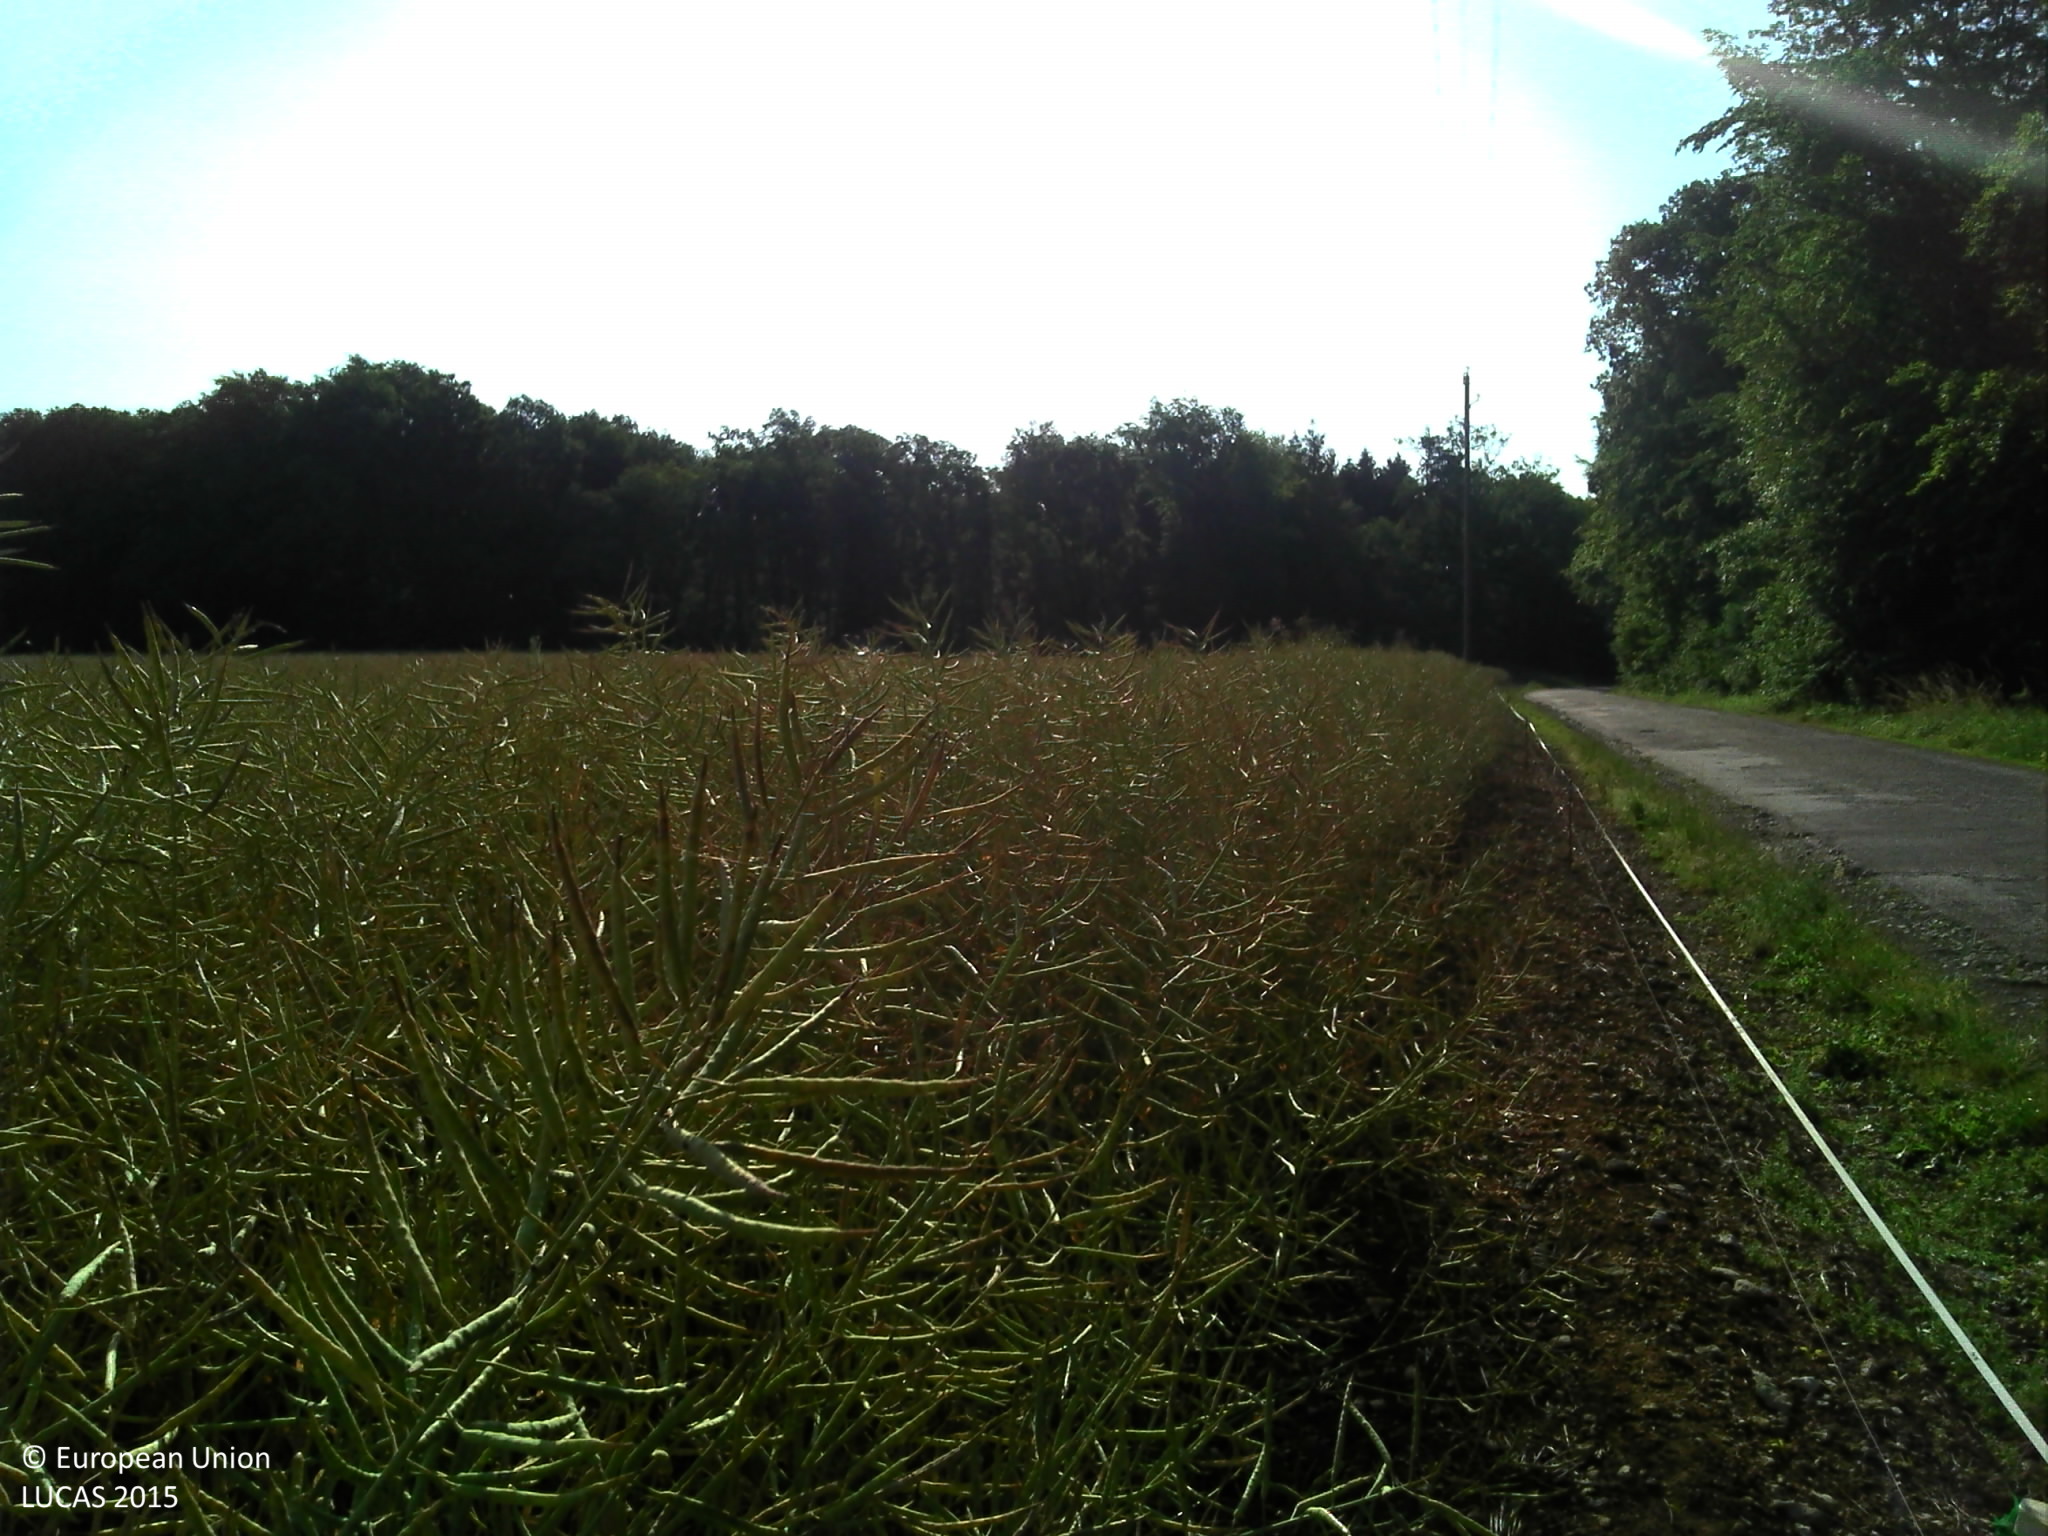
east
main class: Cropland
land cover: Rape and turnip rape
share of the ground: > 75 %
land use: Agriculture (excluding fallow land and kitchen gardens)
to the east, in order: Rape and turnip rape; Grass margins; Tracks; Grass margins; Broadleaved woodland
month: July
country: FR
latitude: 48.1383
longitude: 5.2287
